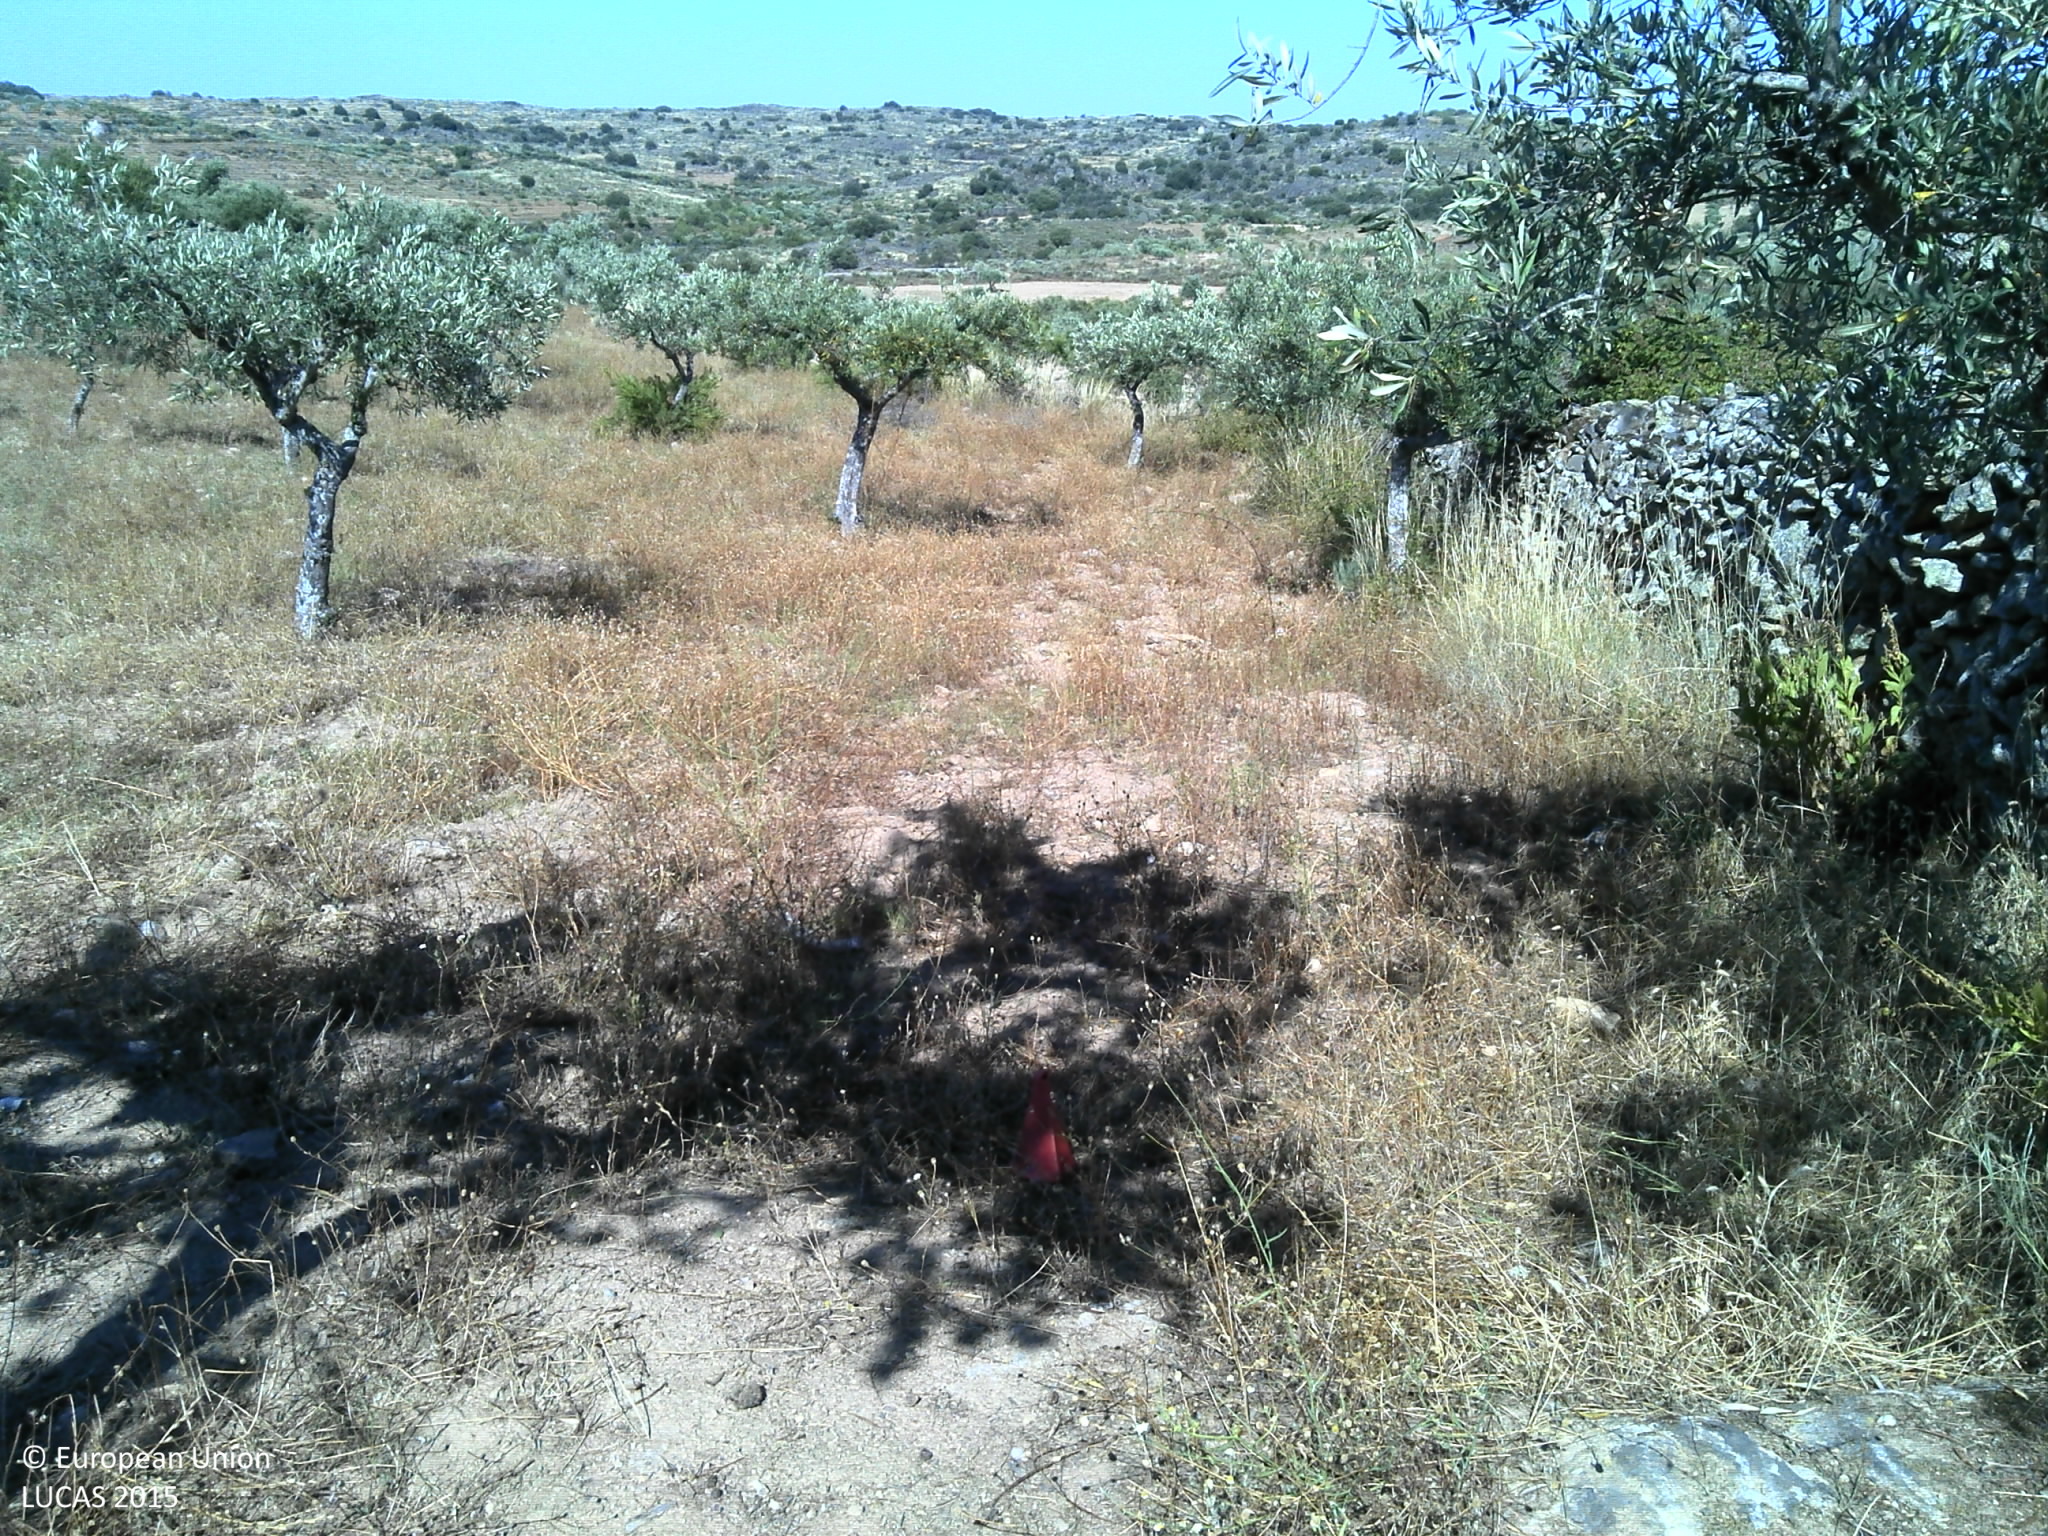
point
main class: Cropland
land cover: Olive groves
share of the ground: 10 - 25 %
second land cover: Spontaneously vegetated surfaces
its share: 25 - 50 %
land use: Agriculture (excluding fallow land and kitchen gardens)
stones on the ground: 10 - 25 %
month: June
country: PT
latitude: 40.9679
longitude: -7.0889
